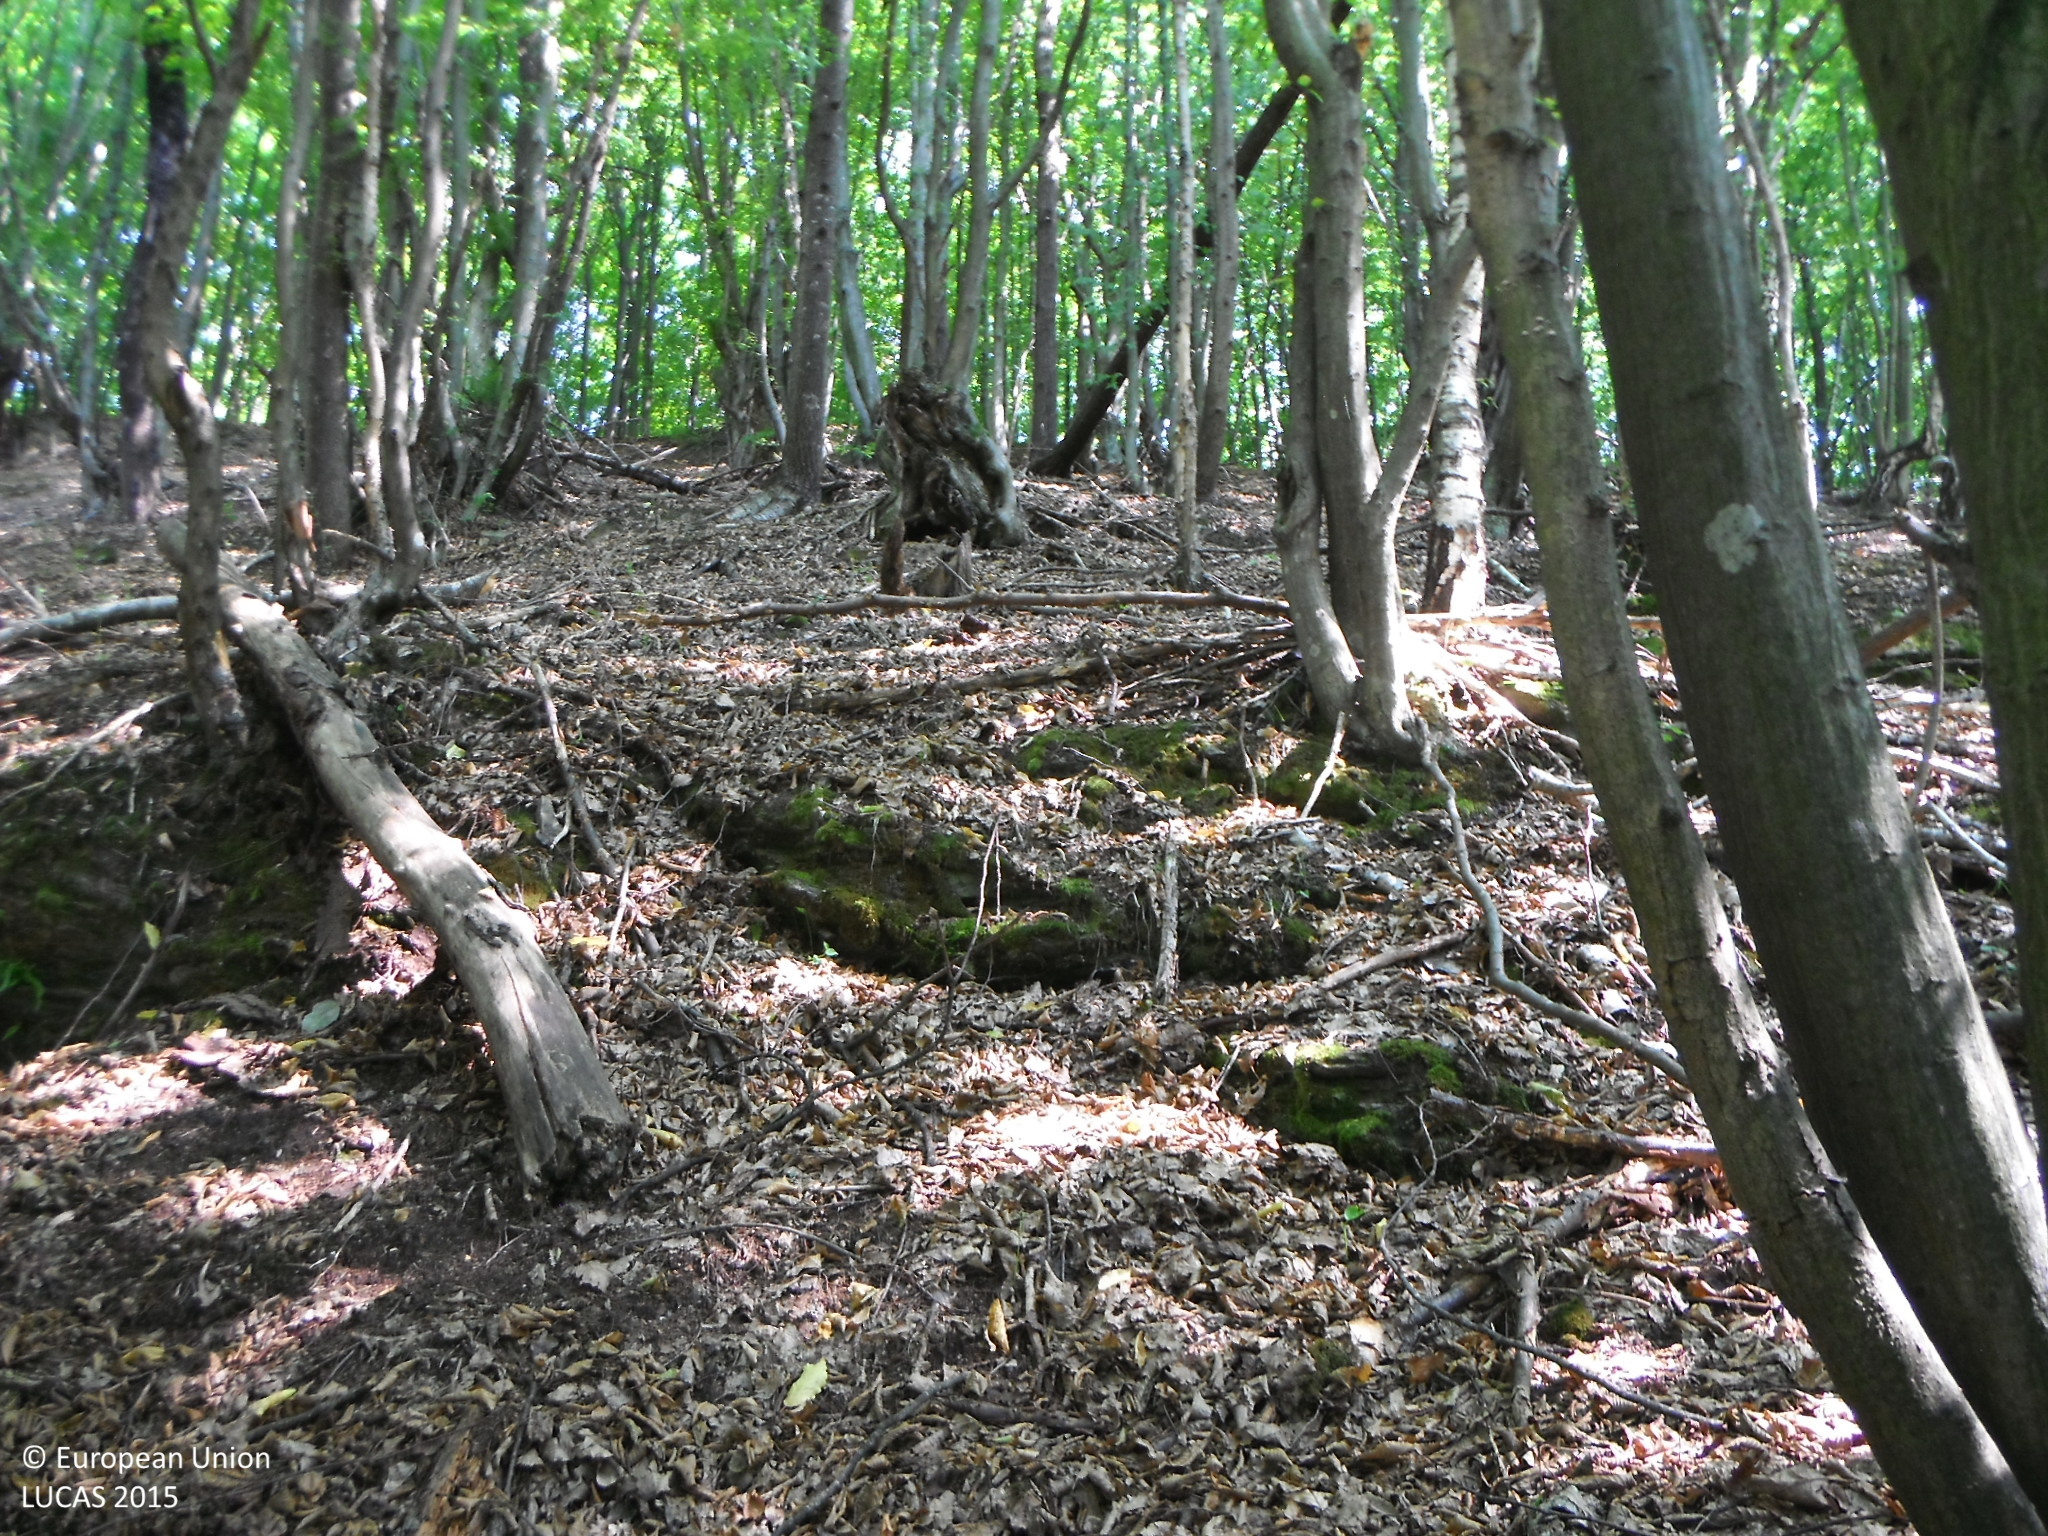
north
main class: Woodland
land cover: Broadleaved woodland
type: beech forest
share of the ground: > 75 %
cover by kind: broadleaved forest trees 100 %
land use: Forestry
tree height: > 5 m
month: August
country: SK
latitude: 48.7552
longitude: 20.3030
